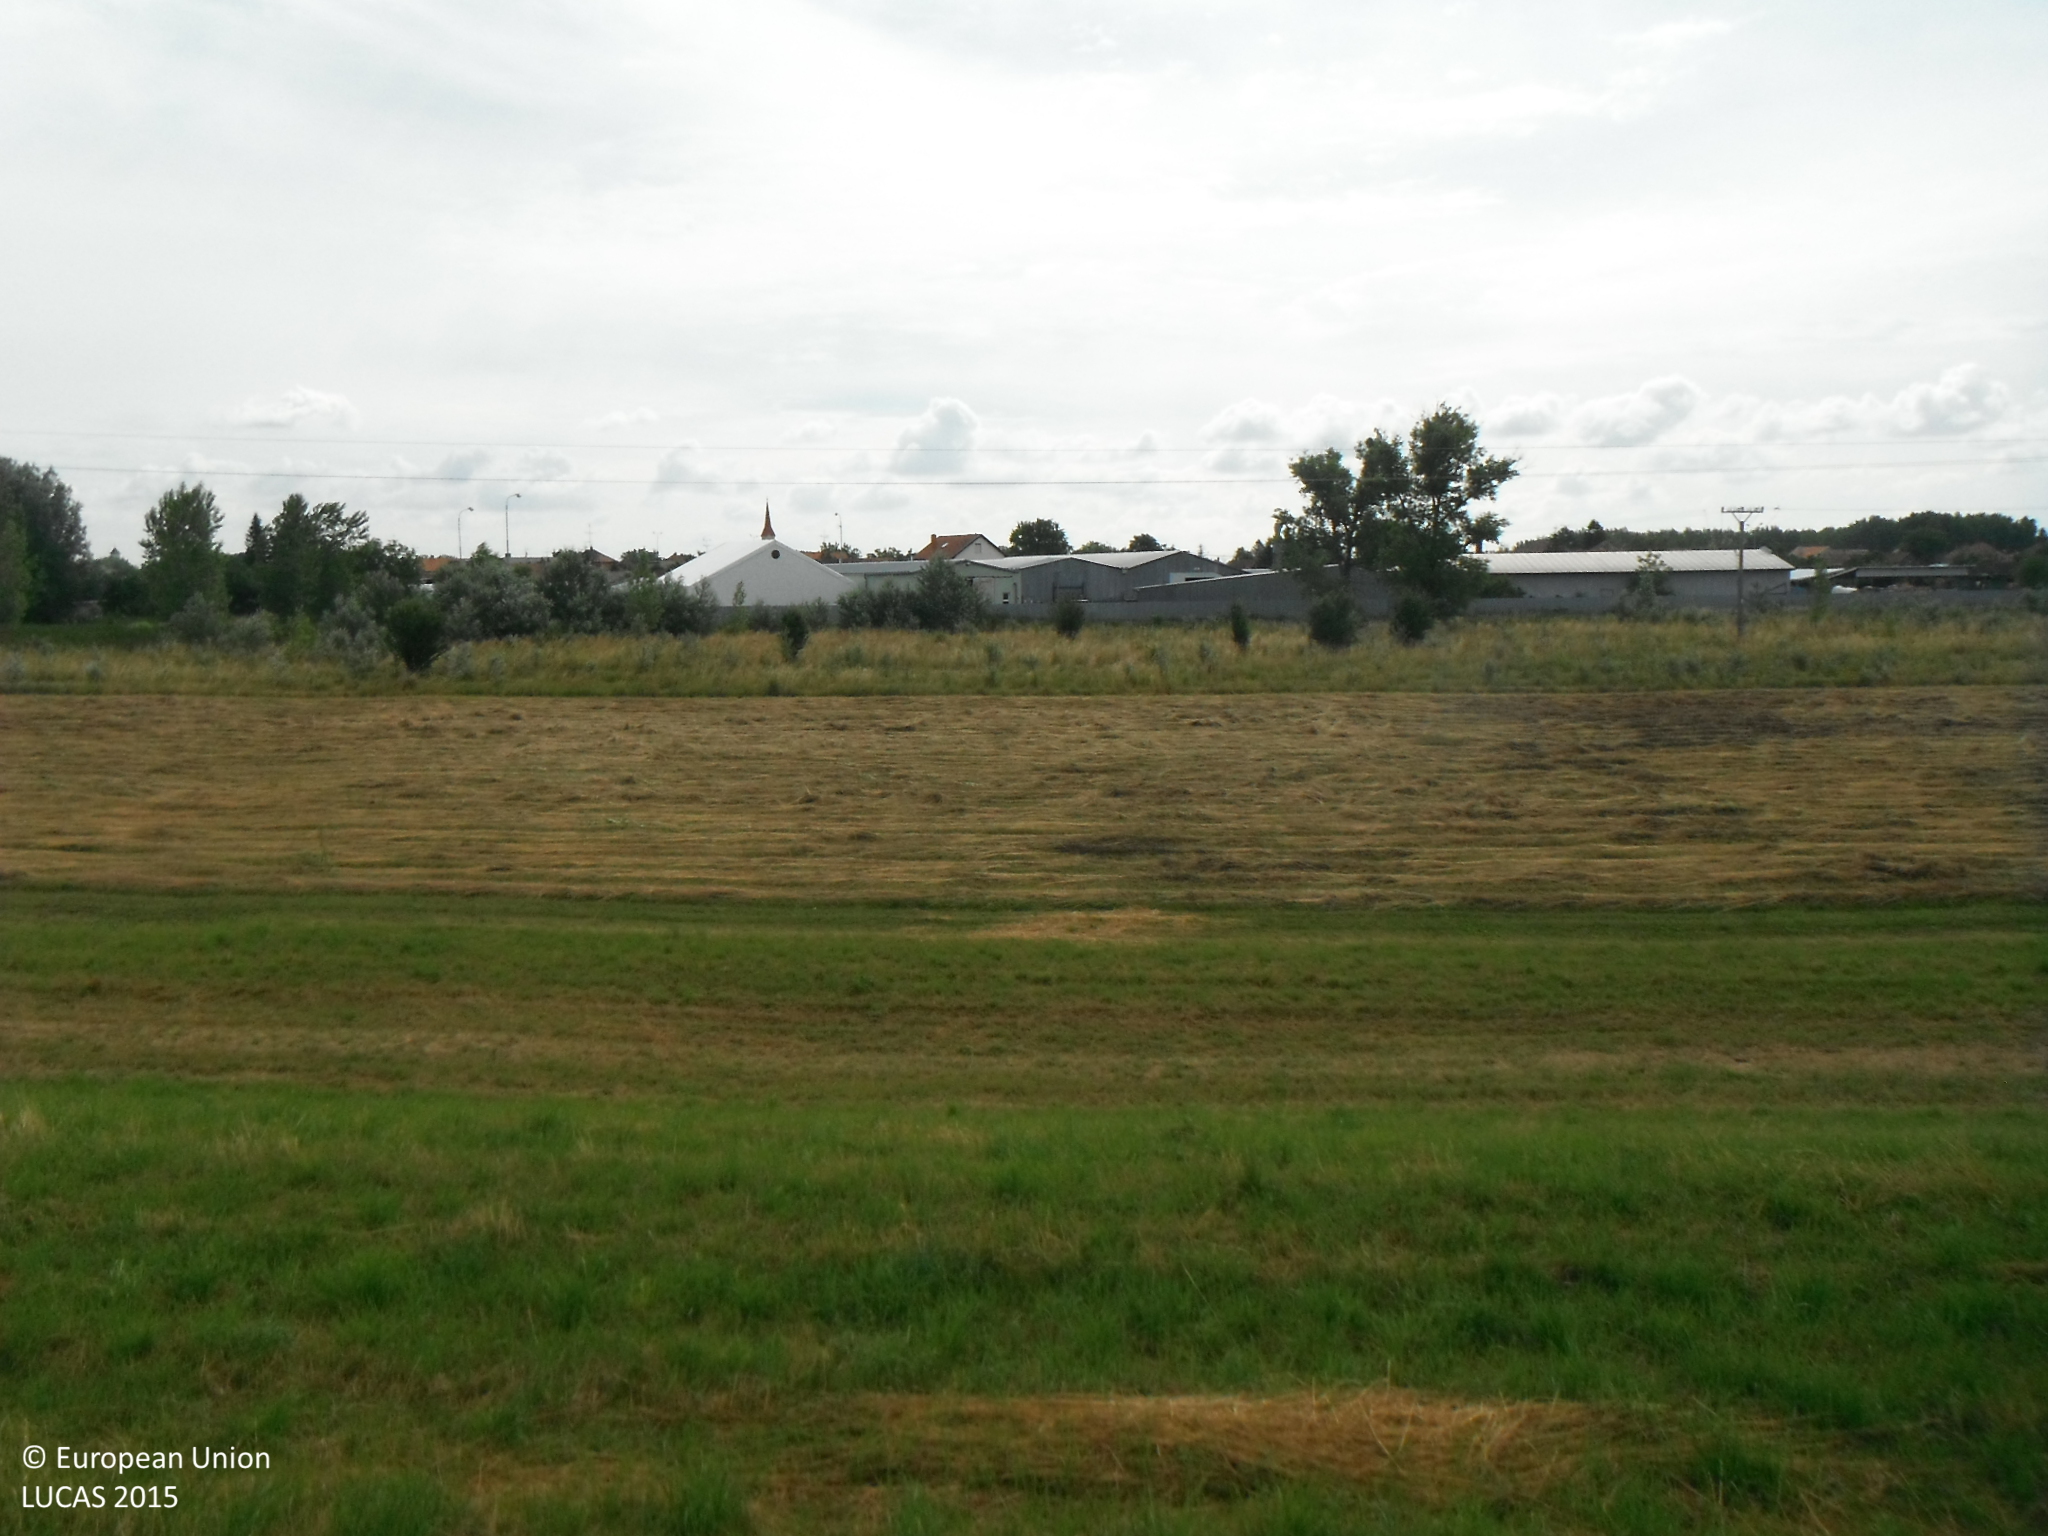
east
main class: Grassland
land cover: Grassland without tree/shrub cover
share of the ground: > 75 %
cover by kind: herbaceous plants 100 %
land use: Protection infrastructures
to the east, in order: Grassland without tree/shrub cover; Grassland with sparse tree/shrub cover; Spontaneously vegetated surfaces; Ditches and canals; Spontaneously vegetated surfaces; Artificial constructions in urban areas
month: June
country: SK
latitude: 47.9245
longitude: 18.1095
